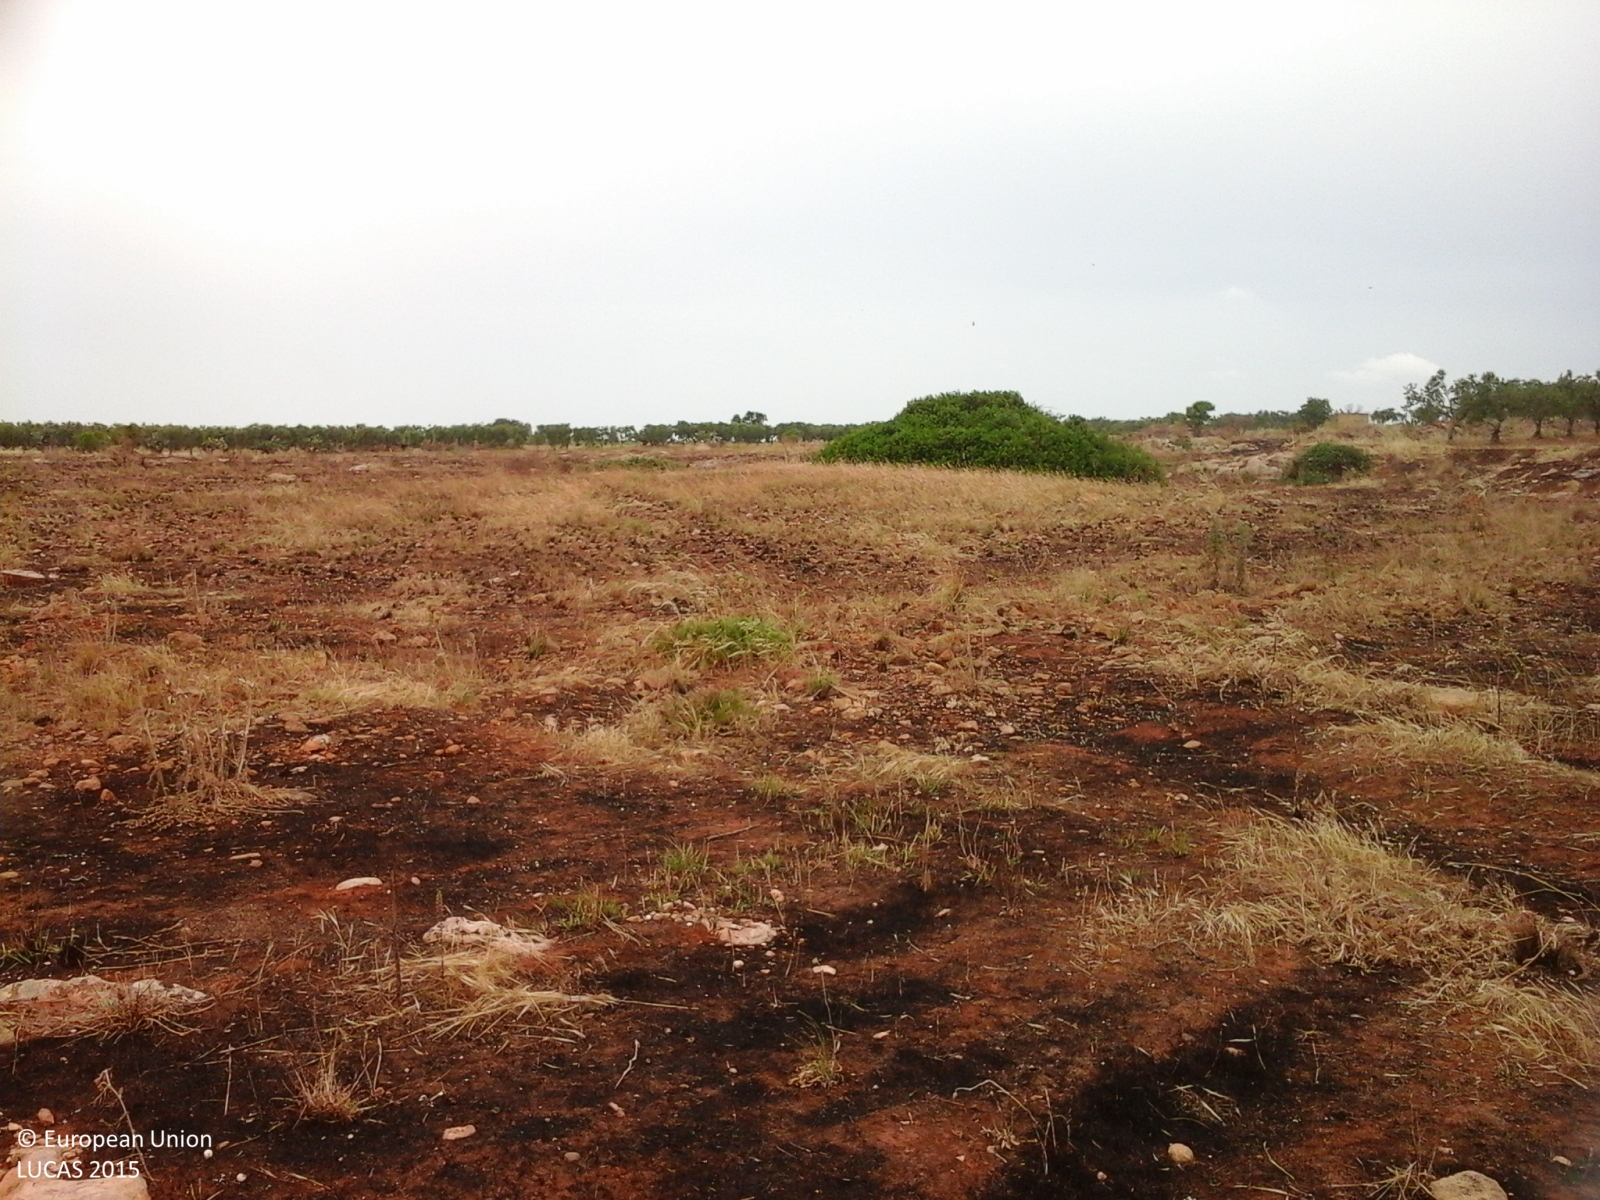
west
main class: Grassland
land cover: Grassland with sparse tree/shrub cover
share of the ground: > 75 %
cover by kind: consolidated bare surface 65 %, herbaceous plants 20 %, shrubs 10 %, coniferous forest trees 5 %
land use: Semi-natural and natural areas not in use
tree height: < 5 m
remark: Burnt area
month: May
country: IT
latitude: 37.6168
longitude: 12.7546
